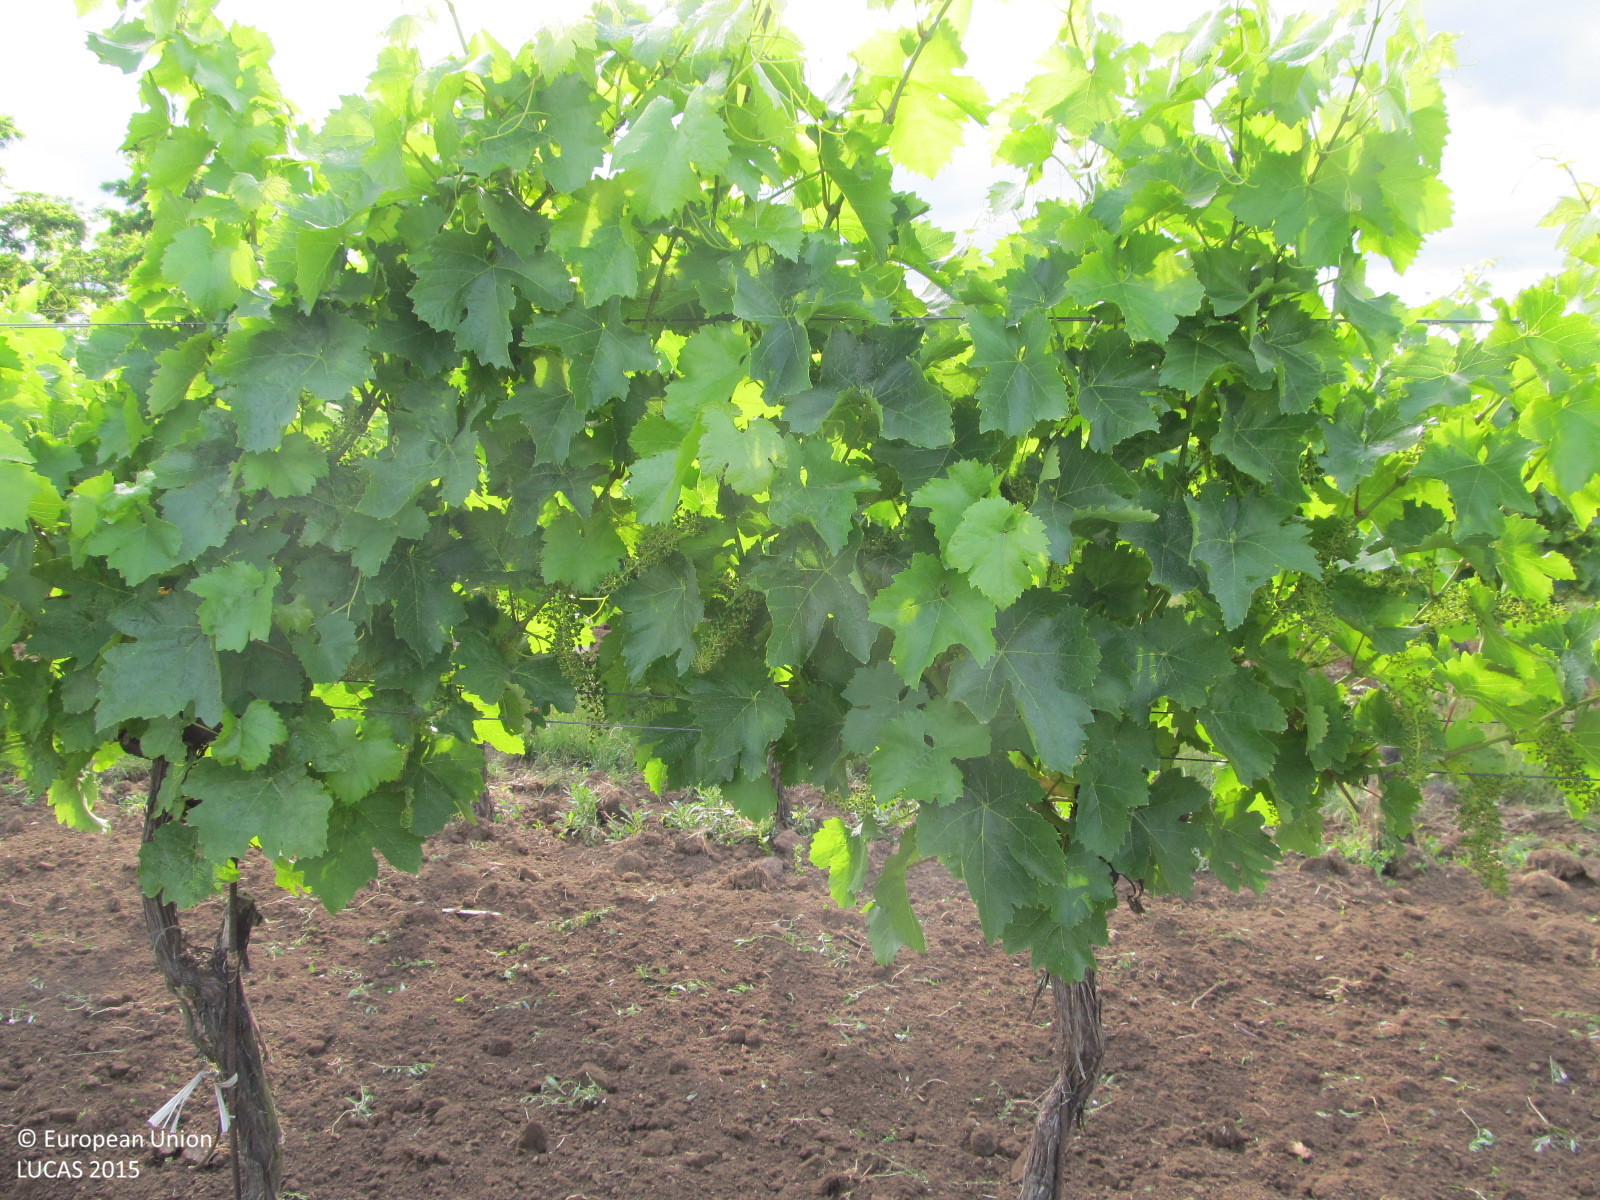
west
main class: Cropland
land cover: Vineyards
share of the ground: 25 - 50 %
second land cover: Grassland without tree/shrub cover
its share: 50 - 75 %
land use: Agriculture (excluding fallow land and kitchen gardens)
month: June
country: AT
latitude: 48.7397
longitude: 16.1104
